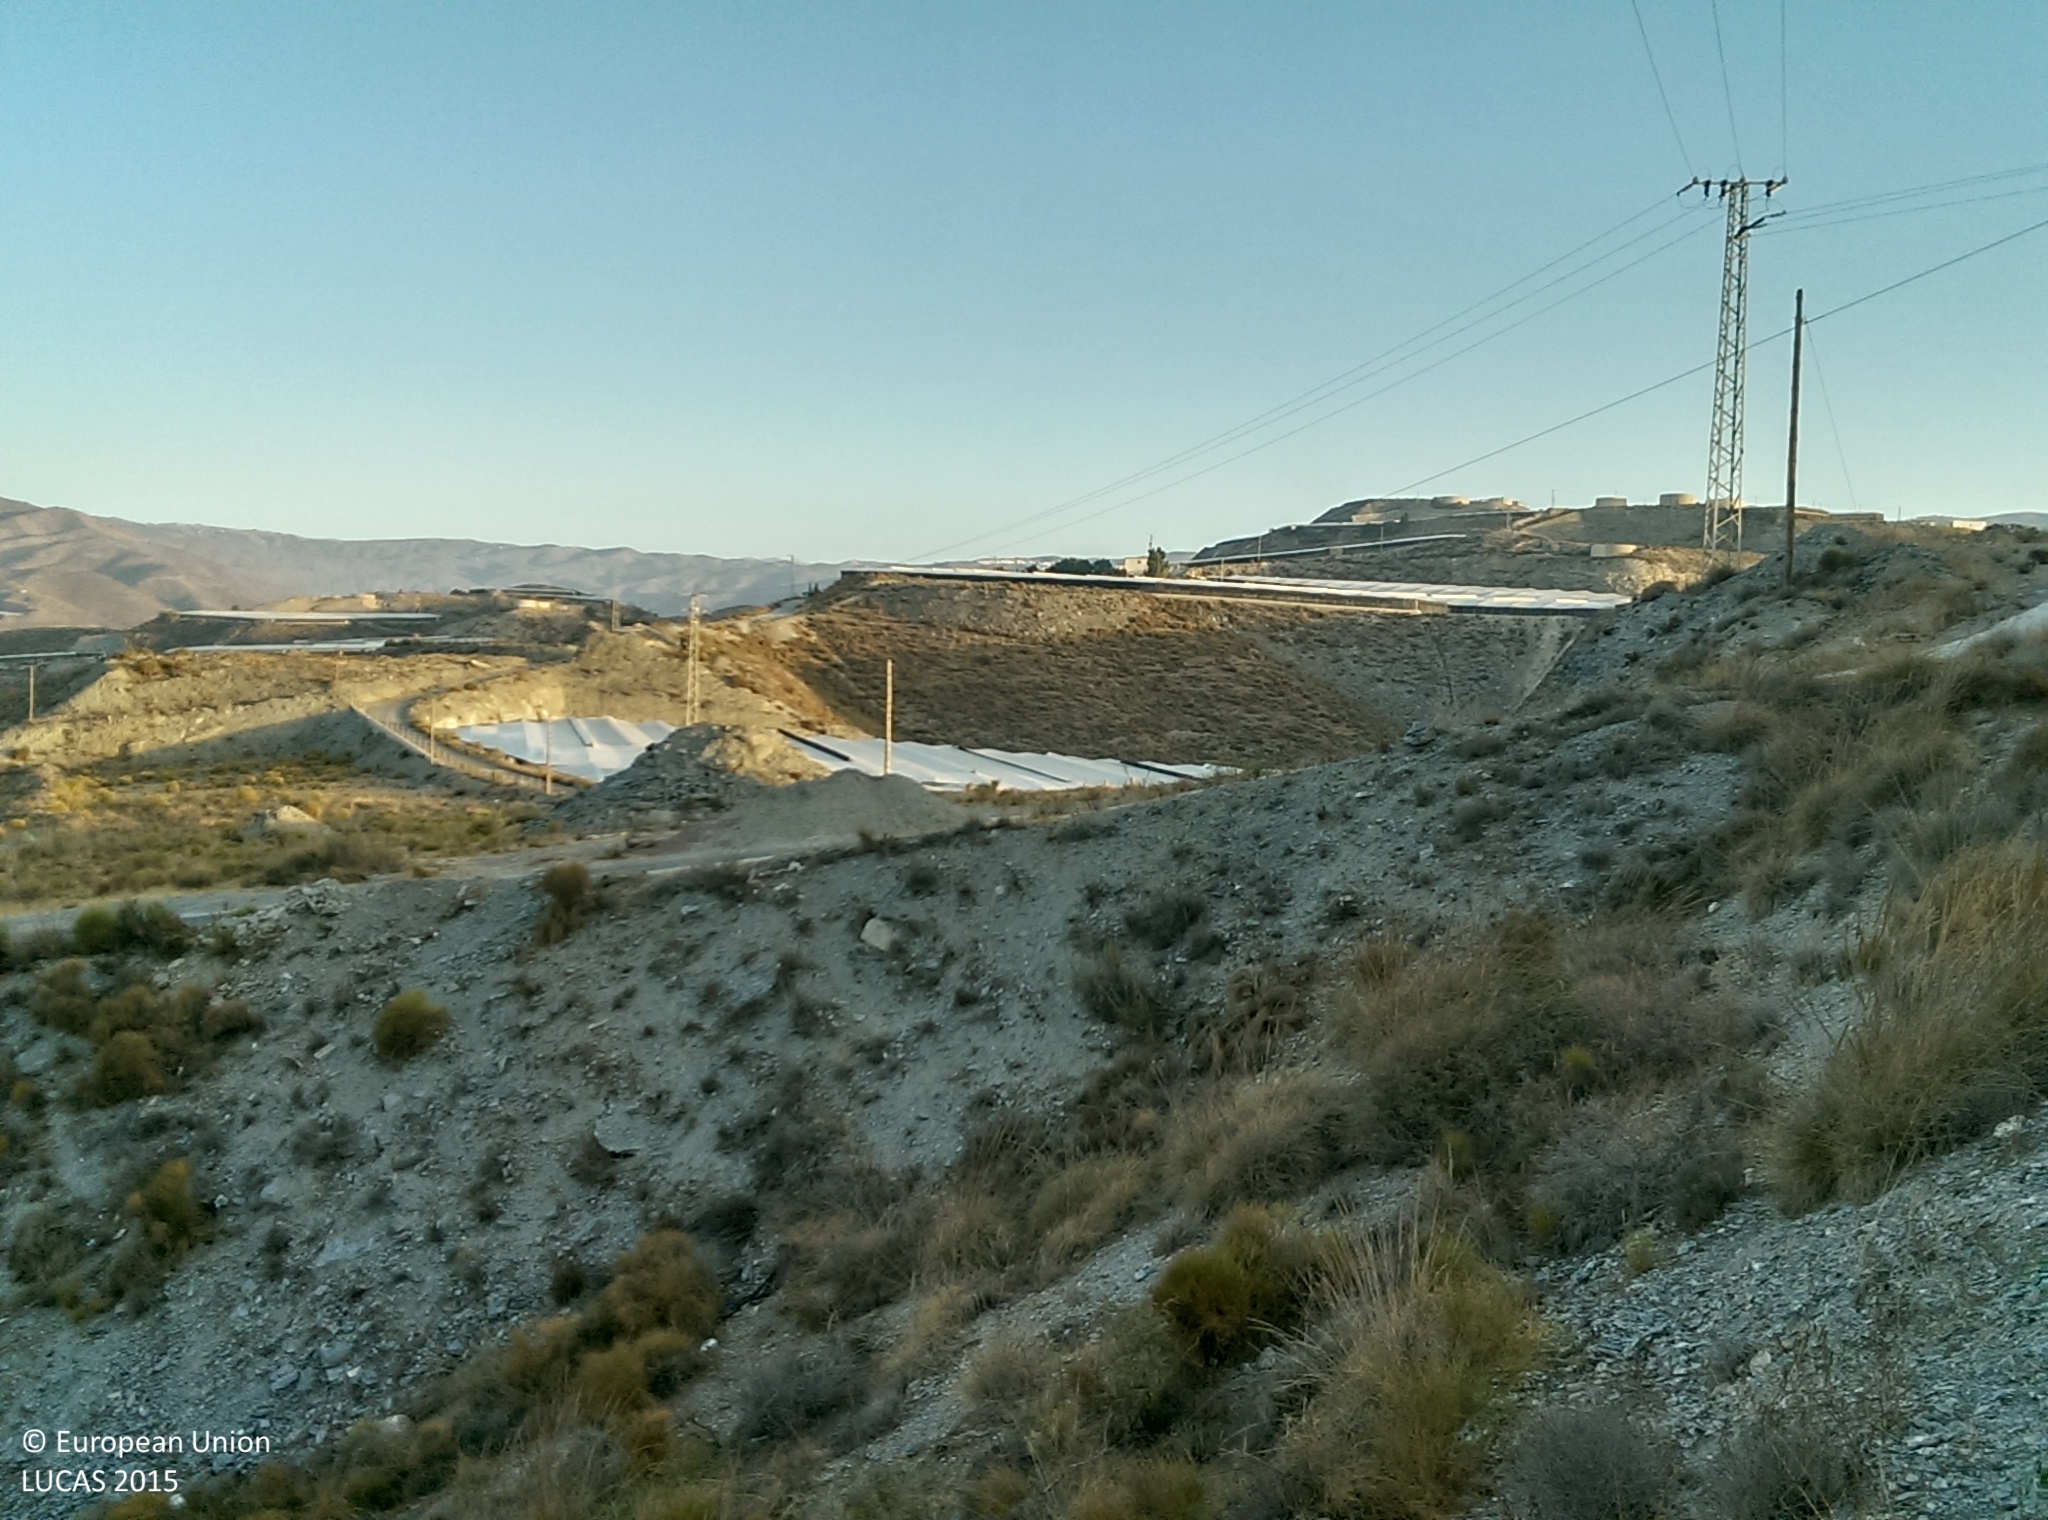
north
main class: Shrubland
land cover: Shrubland without tree cover
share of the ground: 25 - 50 %
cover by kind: shrubs 40 %, herbaceous plants 30 %, unconsolidated bare surface 30 %
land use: Abandoned areas
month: August
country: ES
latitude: 36.7549
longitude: -3.1624
